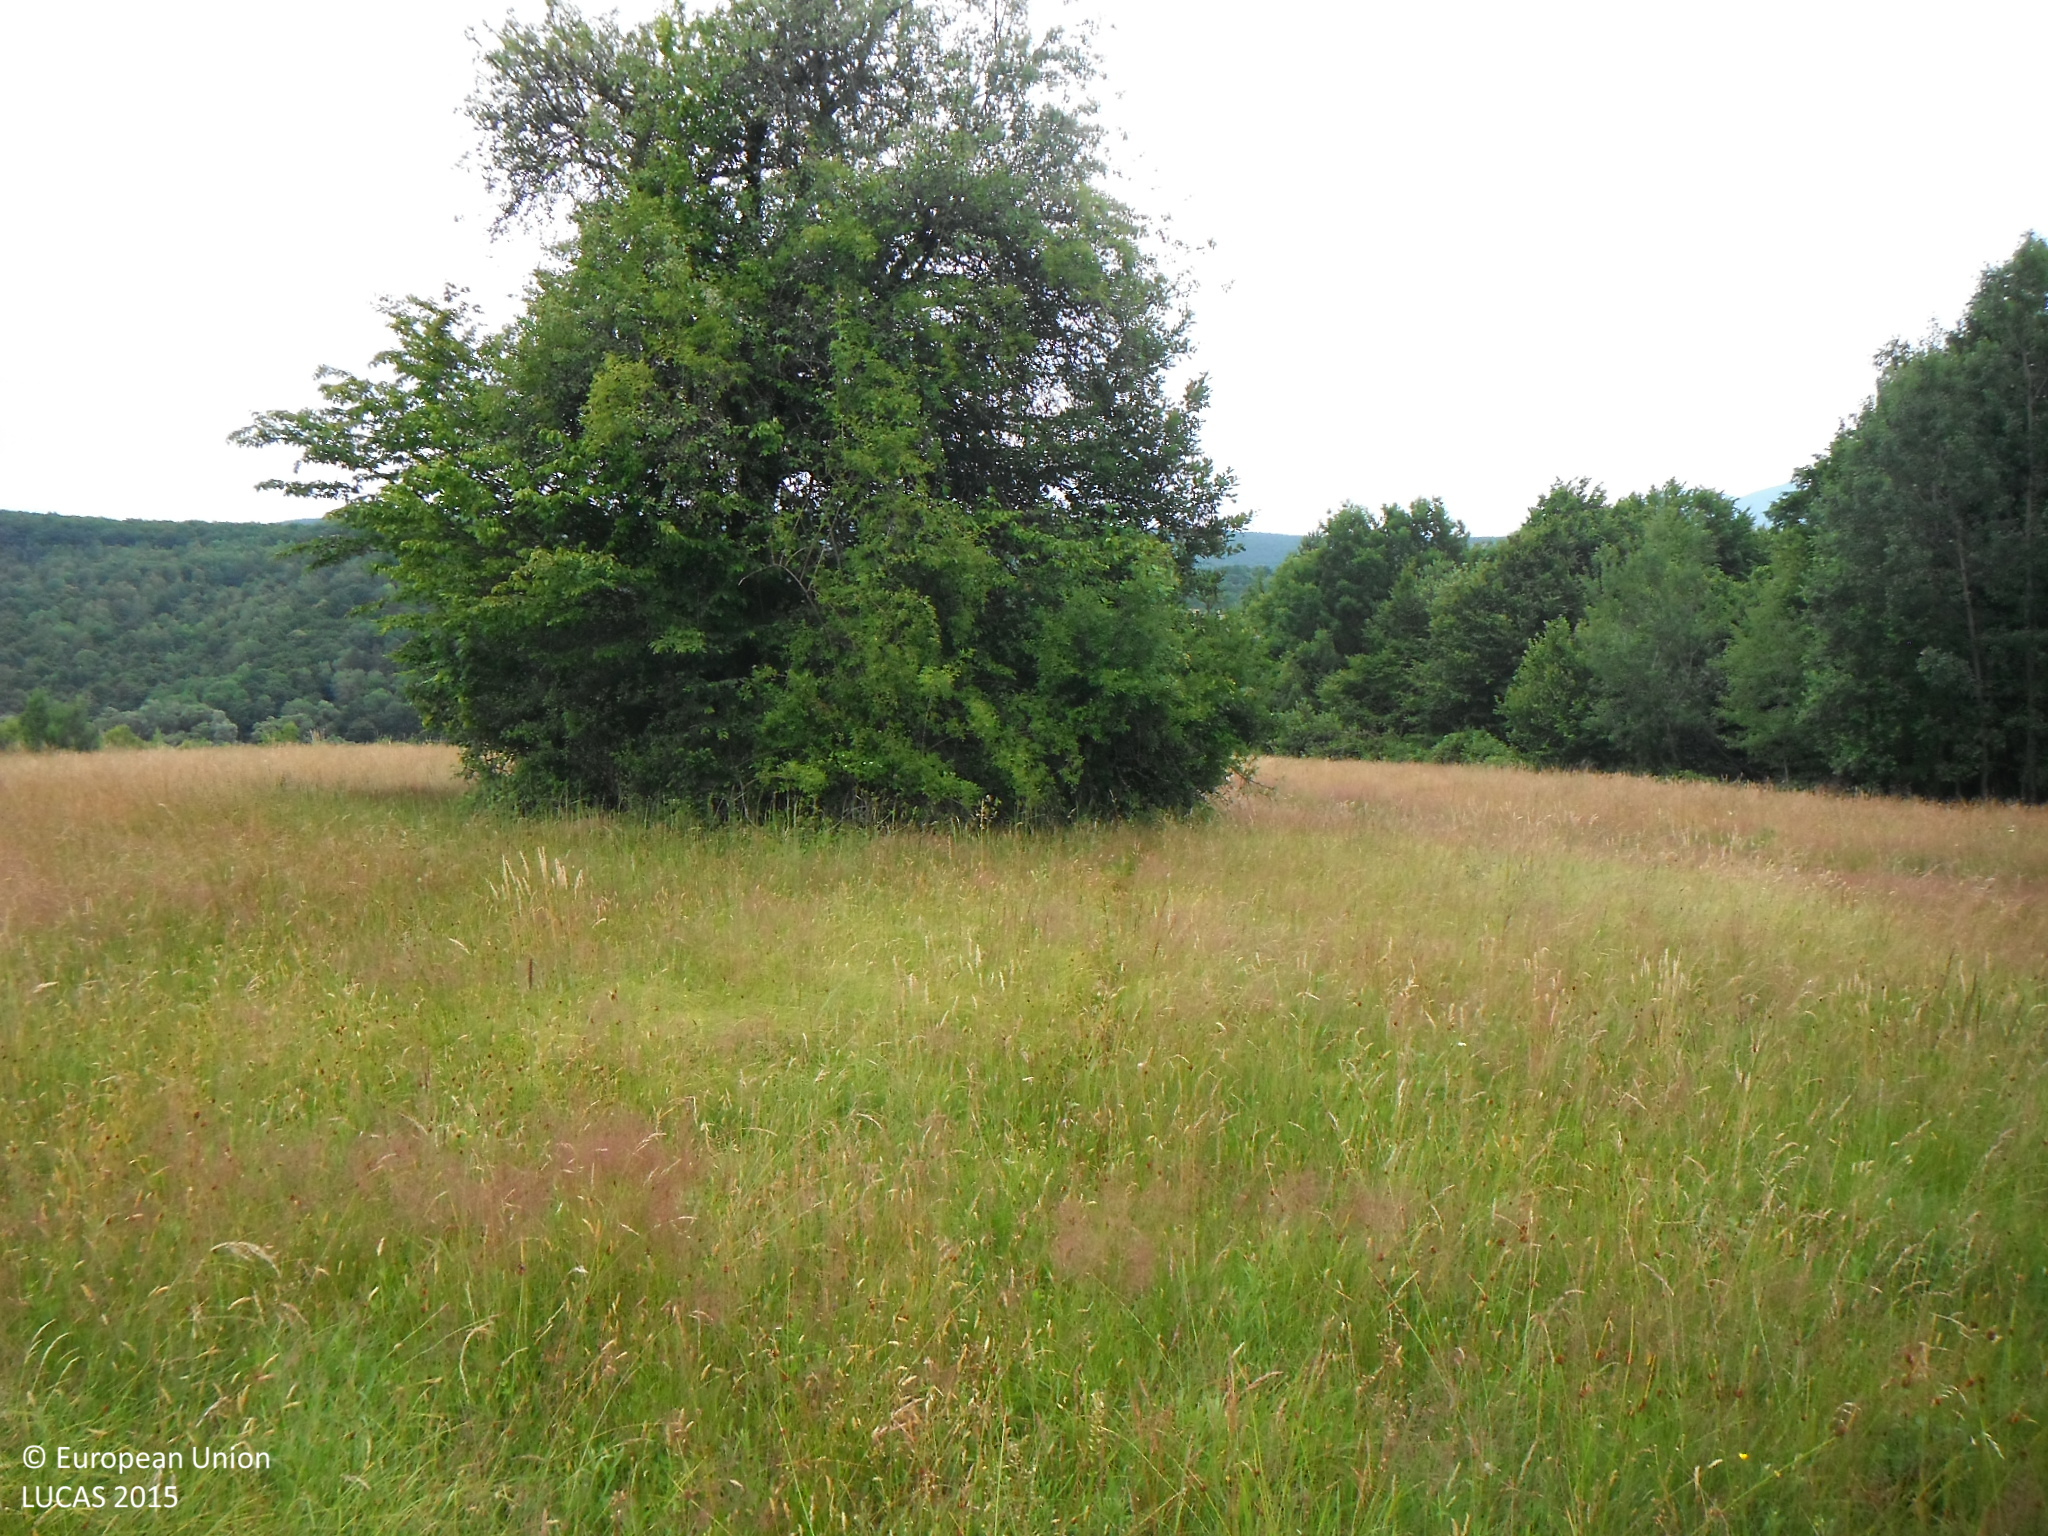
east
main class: Grassland
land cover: Grassland without tree/shrub cover
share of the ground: > 75 %
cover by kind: herbaceous plants 100 %
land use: Agriculture (excluding fallow land and kitchen gardens)
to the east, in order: Grassland without tree/shrub cover; Single bushes/trees; Grassland without tree/shrub cover; Tracks; Grassland without tree/shrub cover
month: June
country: SK
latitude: 49.0034
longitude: 21.9891
